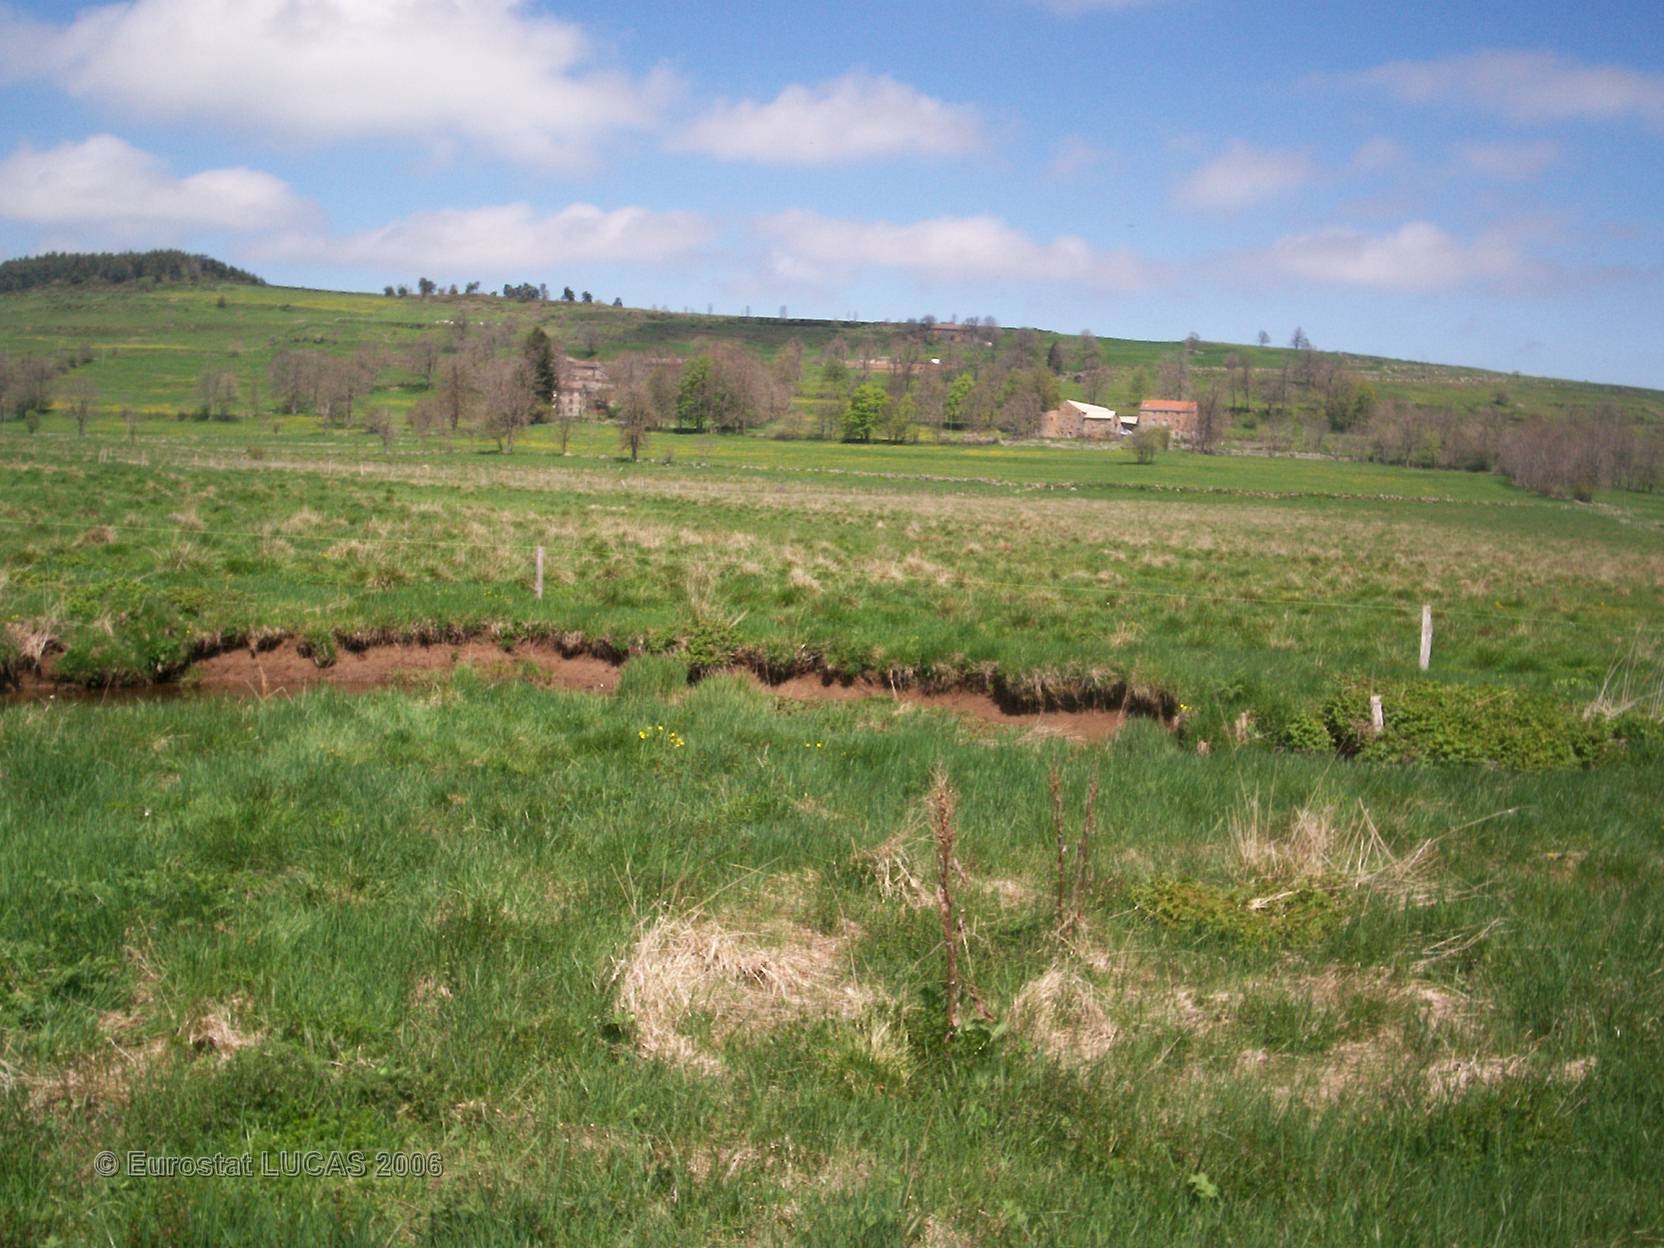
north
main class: Grassland
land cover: Grassland without tree/shrub cover
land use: Agriculture (excluding fallow land and kitchen gardens)
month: May
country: FR
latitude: 45.0200
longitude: 4.2053
